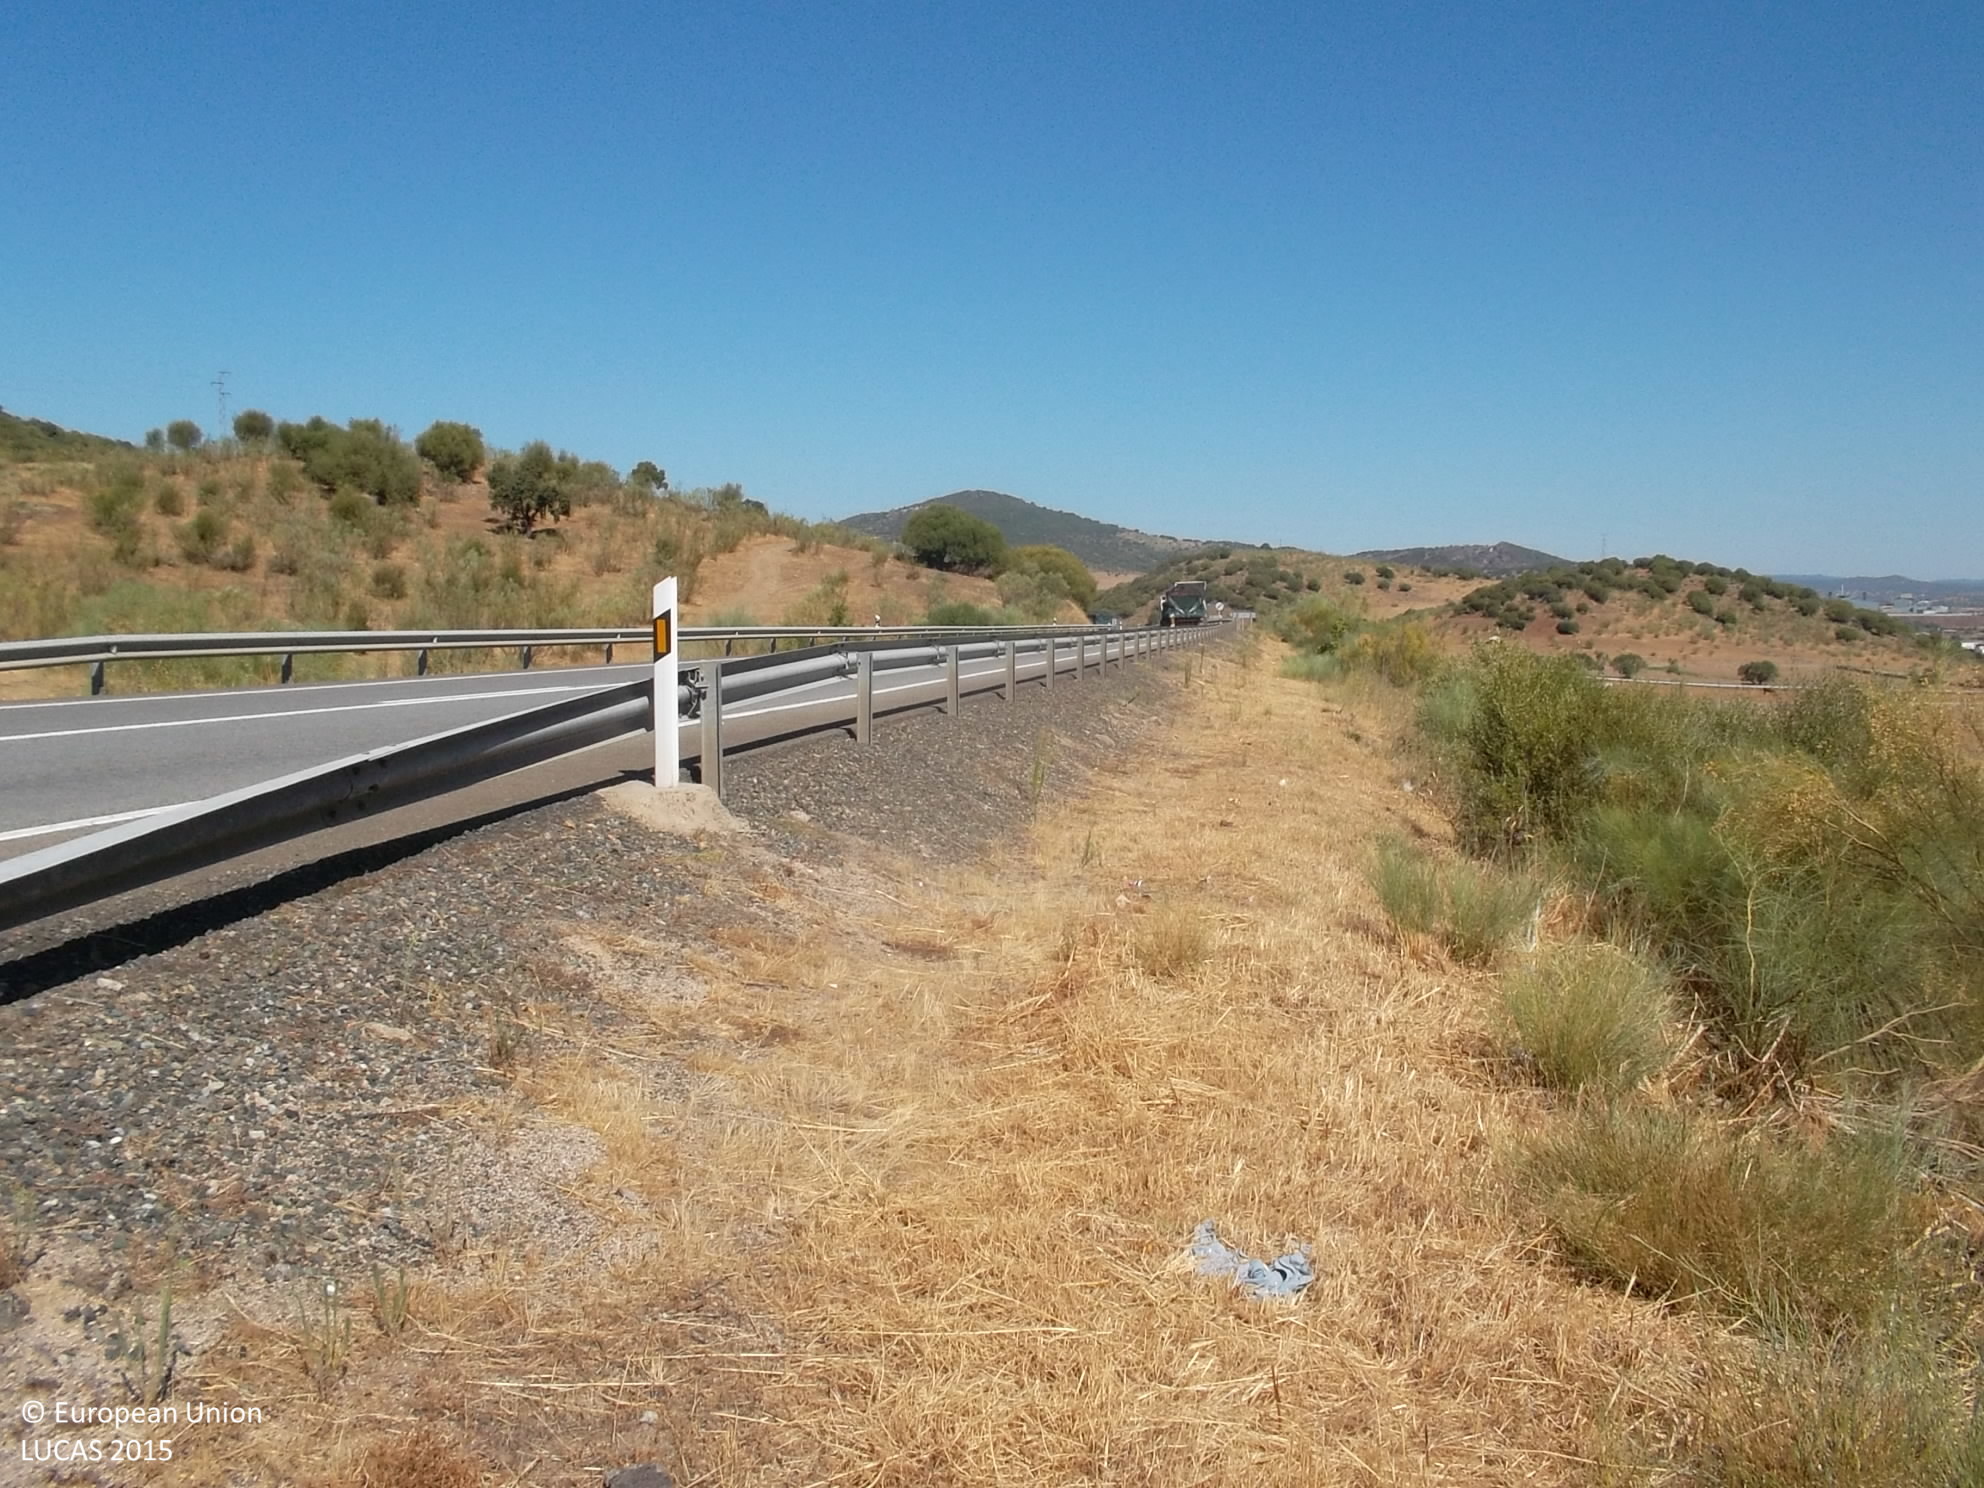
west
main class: Grassland
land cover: Grassland without tree/shrub cover
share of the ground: > 75 %
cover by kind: herbaceous plants 100 %
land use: Agriculture (excluding fallow land and kitchen gardens)
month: August
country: ES
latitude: 38.2878
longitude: -6.7113
